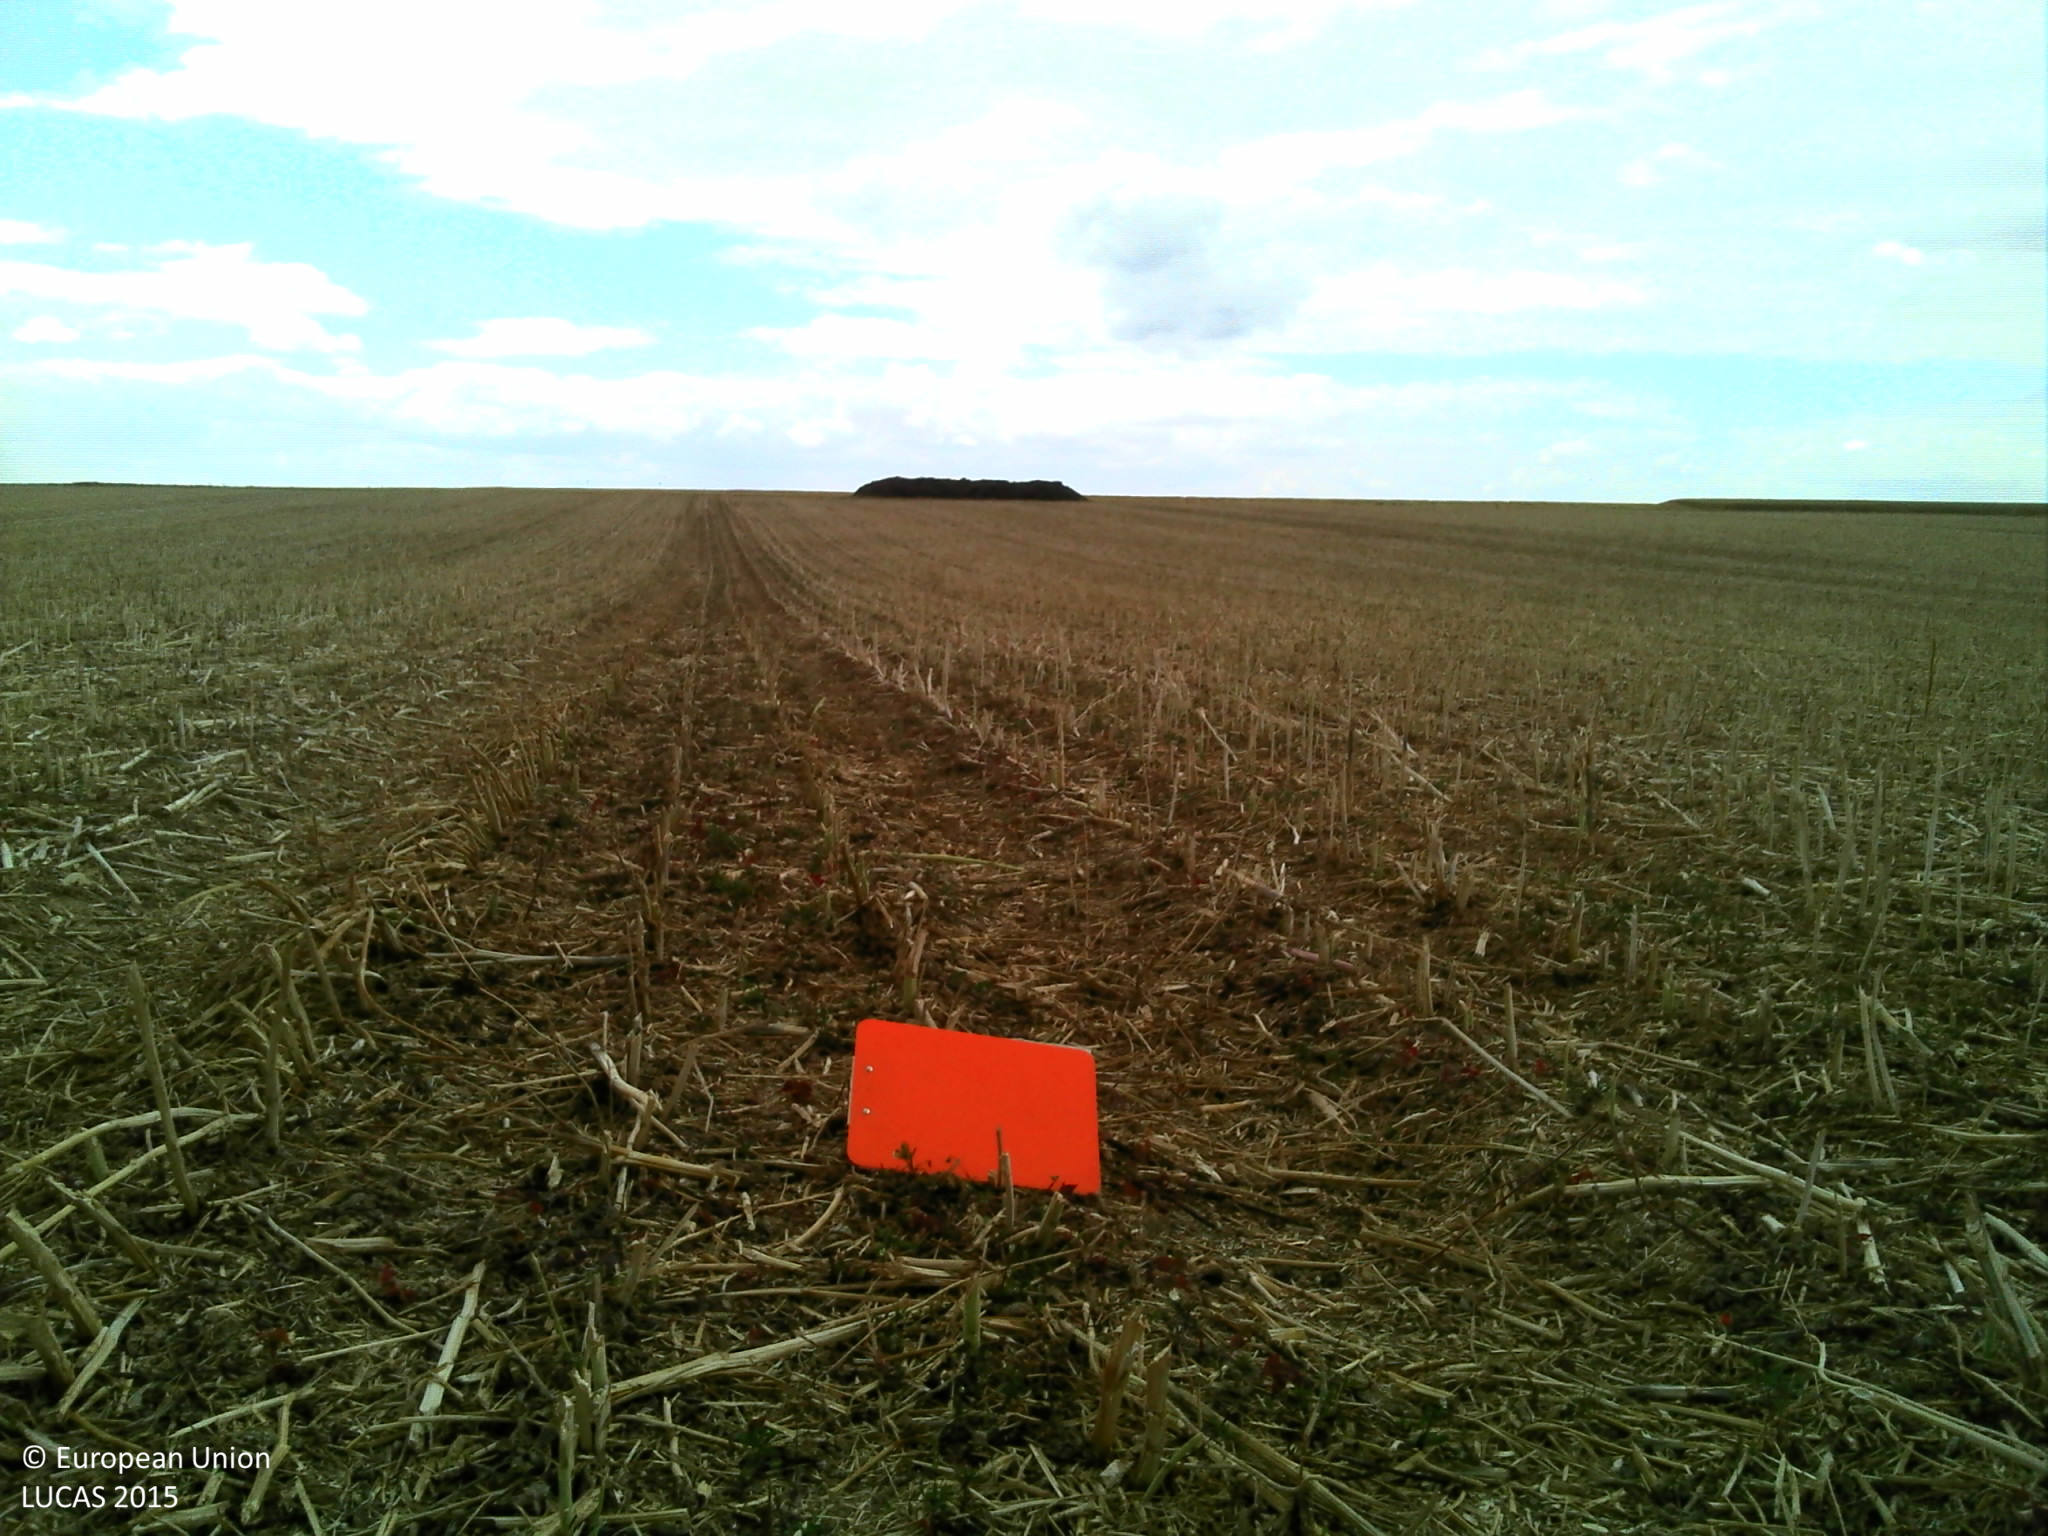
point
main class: Cropland
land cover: Rape and turnip rape
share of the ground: > 75 %
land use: Agriculture (excluding fallow land and kitchen gardens)
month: July
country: FR
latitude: 49.0990
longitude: 4.5594
